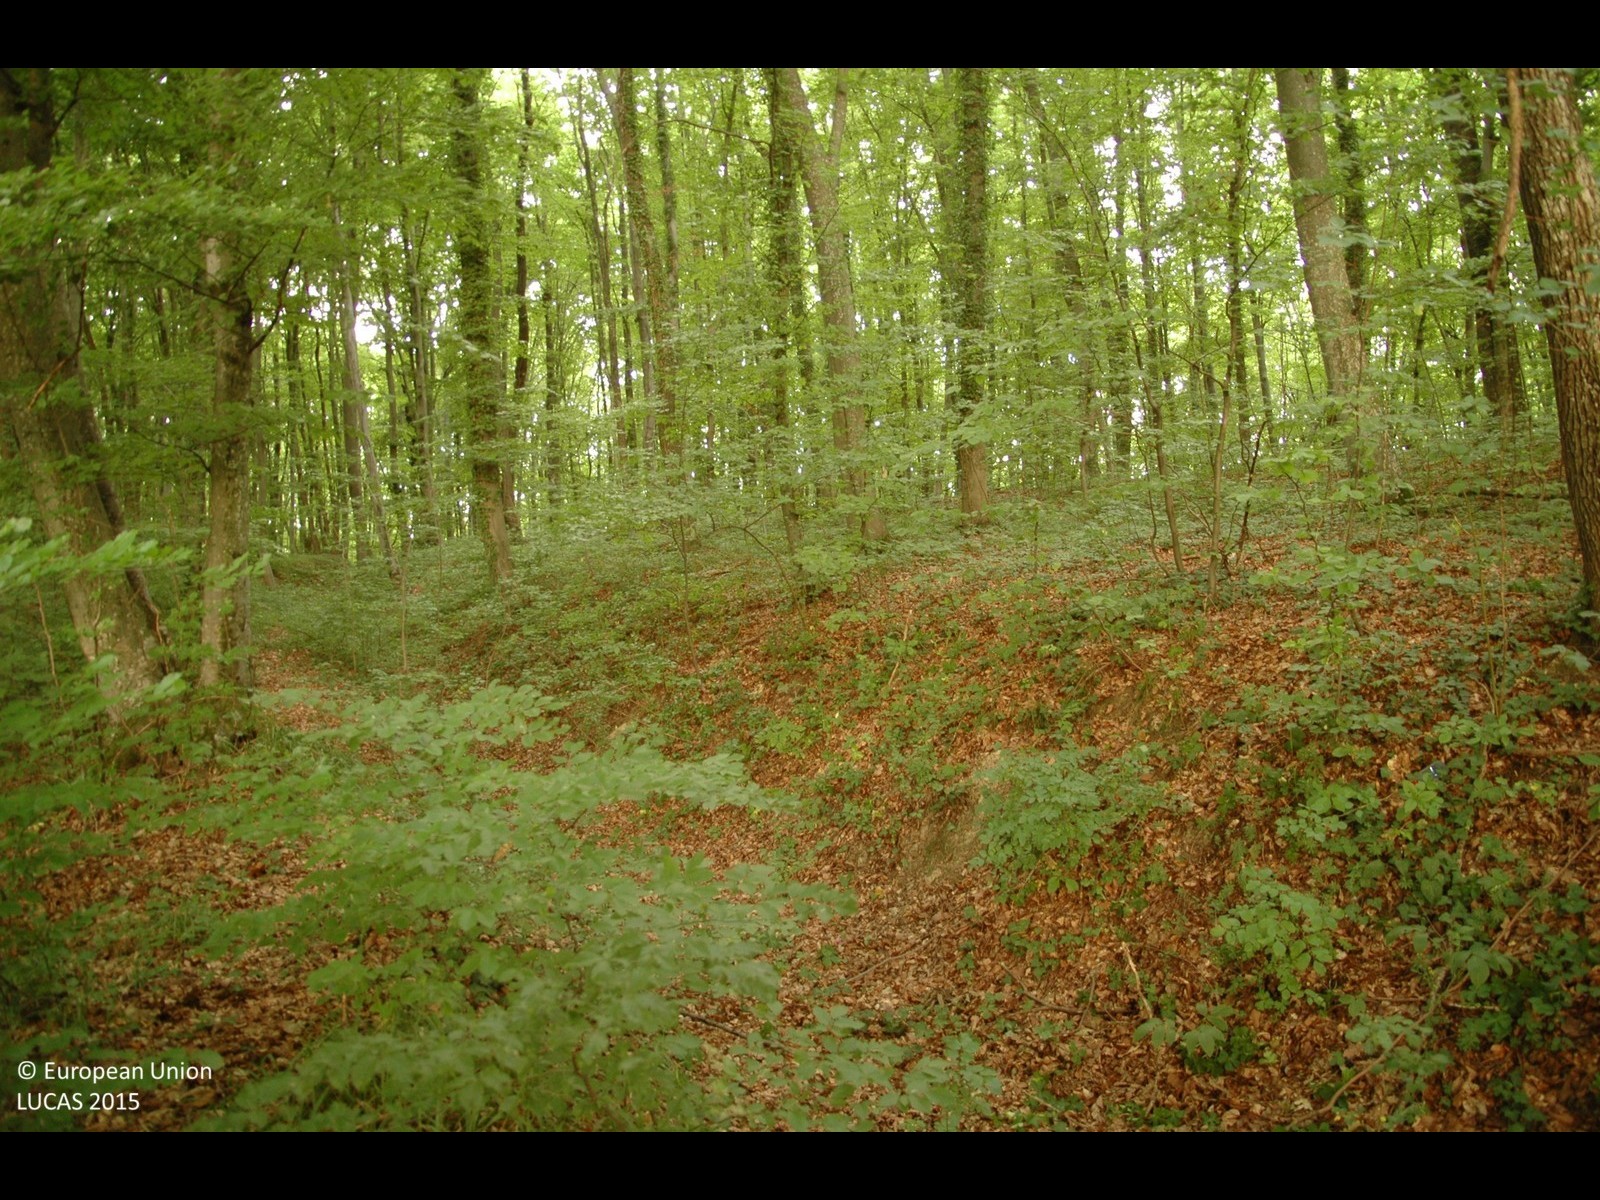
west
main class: Woodland
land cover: Broadleaved woodland
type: beech forest
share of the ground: > 75 %
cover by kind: broadleaved forest trees 100 %
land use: Forestry
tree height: > 5 m
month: July
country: HR
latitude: 46.2414
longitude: 16.2377
